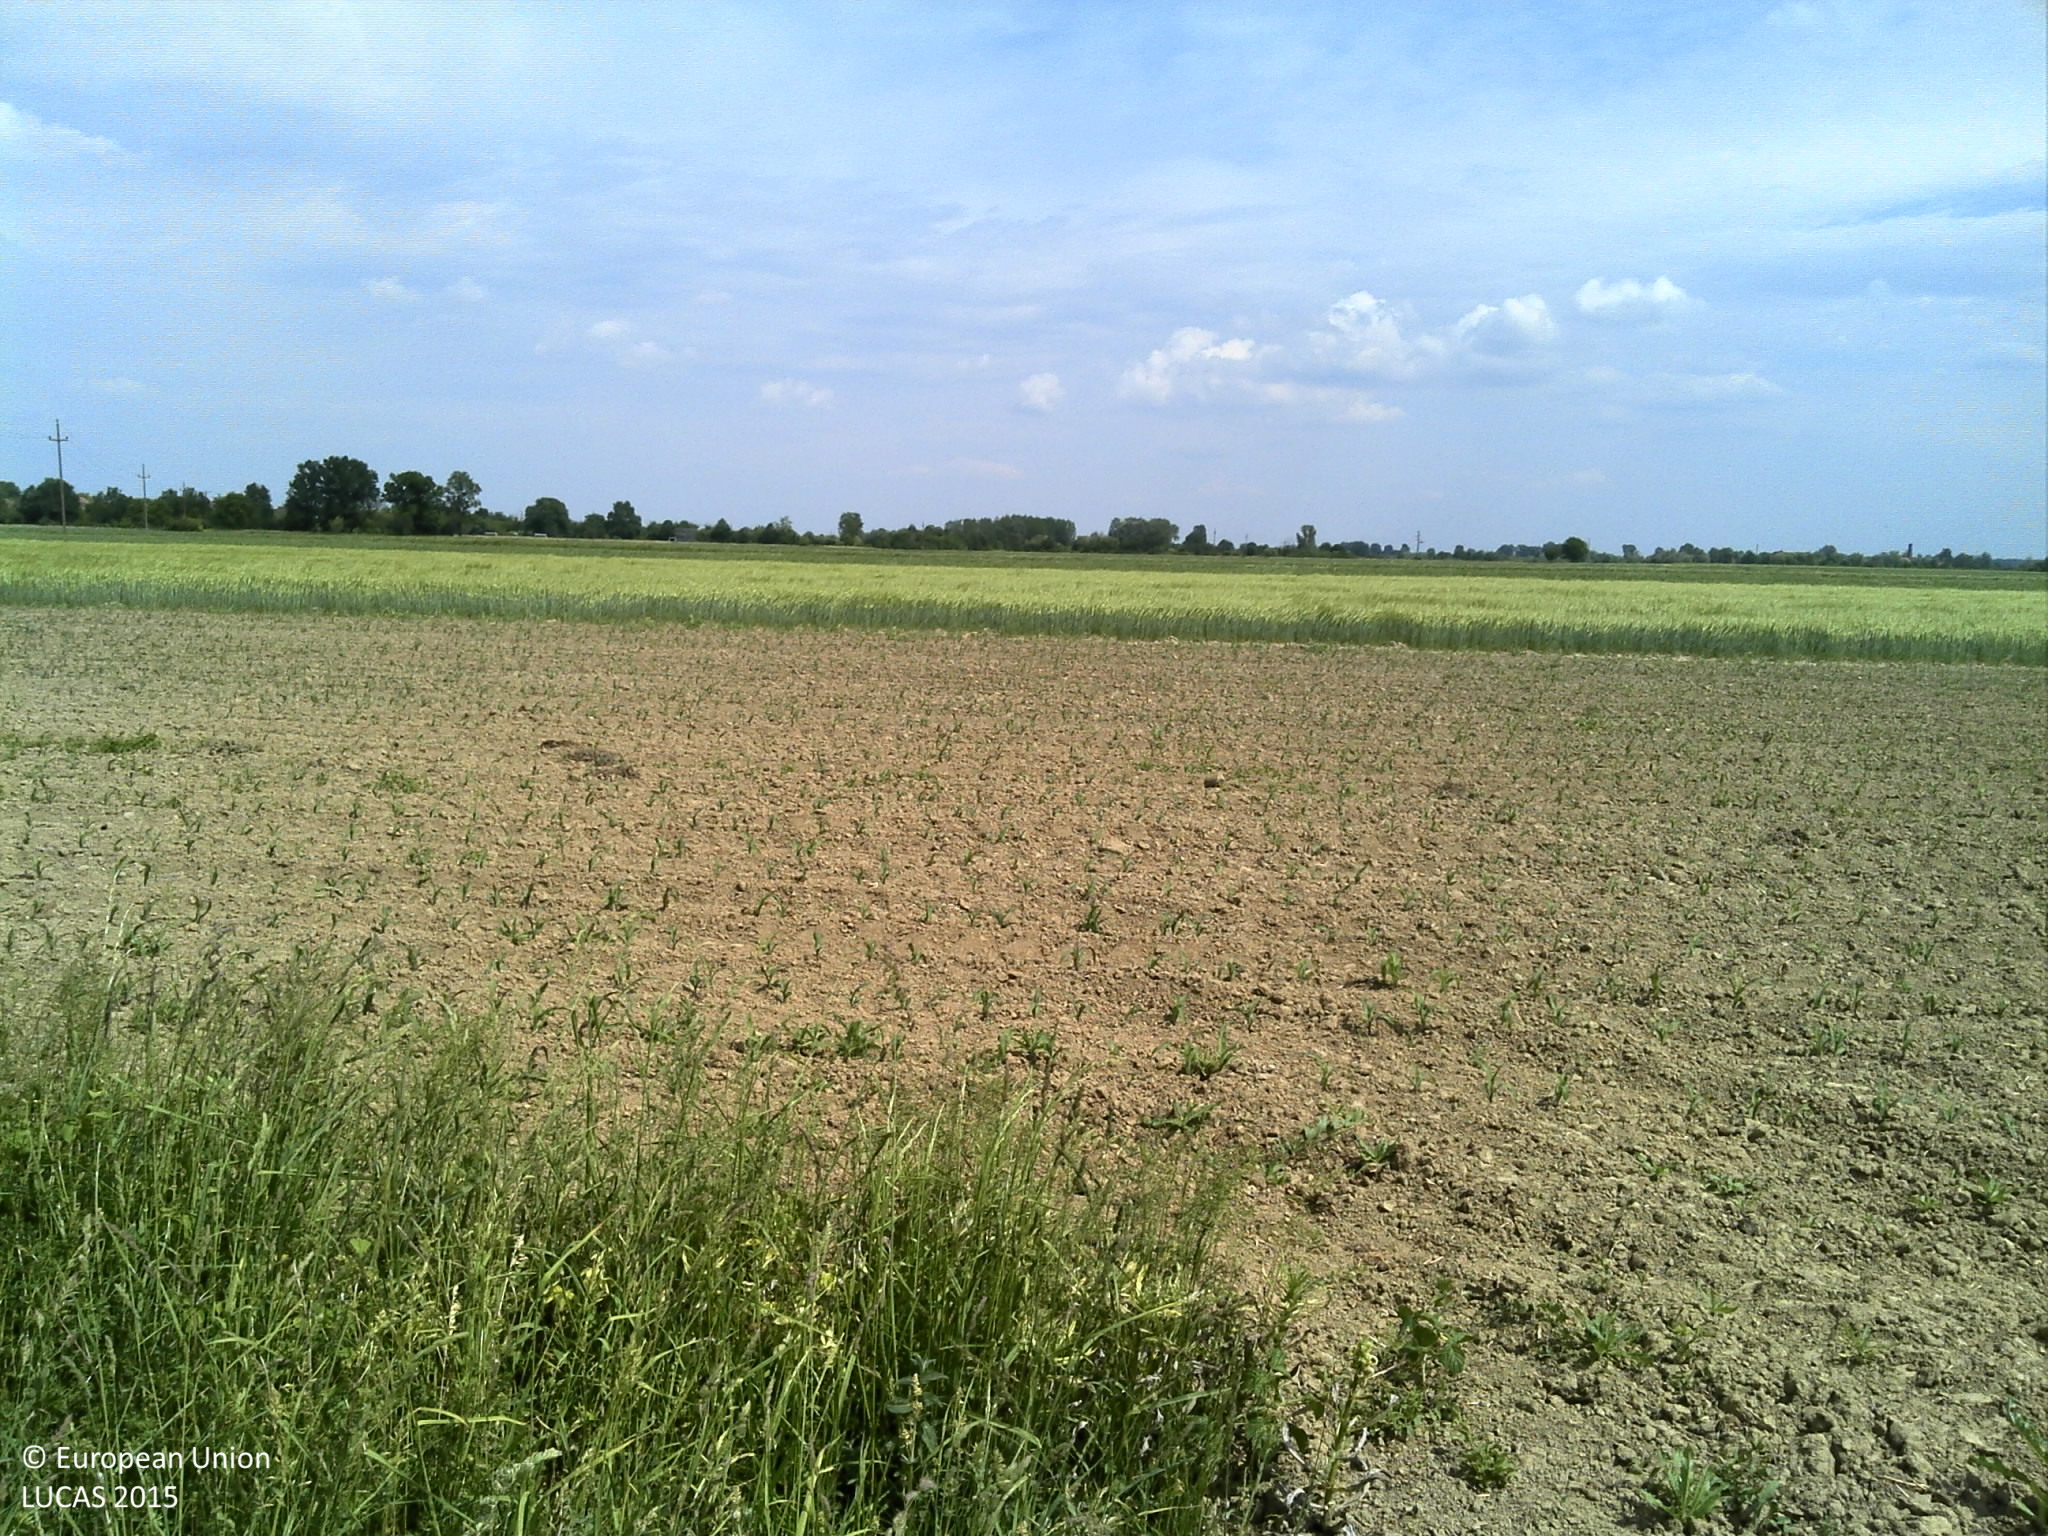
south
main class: Grassland
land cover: Spontaneously vegetated surfaces
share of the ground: > 75 %
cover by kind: herbaceous plants 100 %
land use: Semi-natural and natural areas not in use
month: May
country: HR
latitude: 45.6554
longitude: 18.2057
